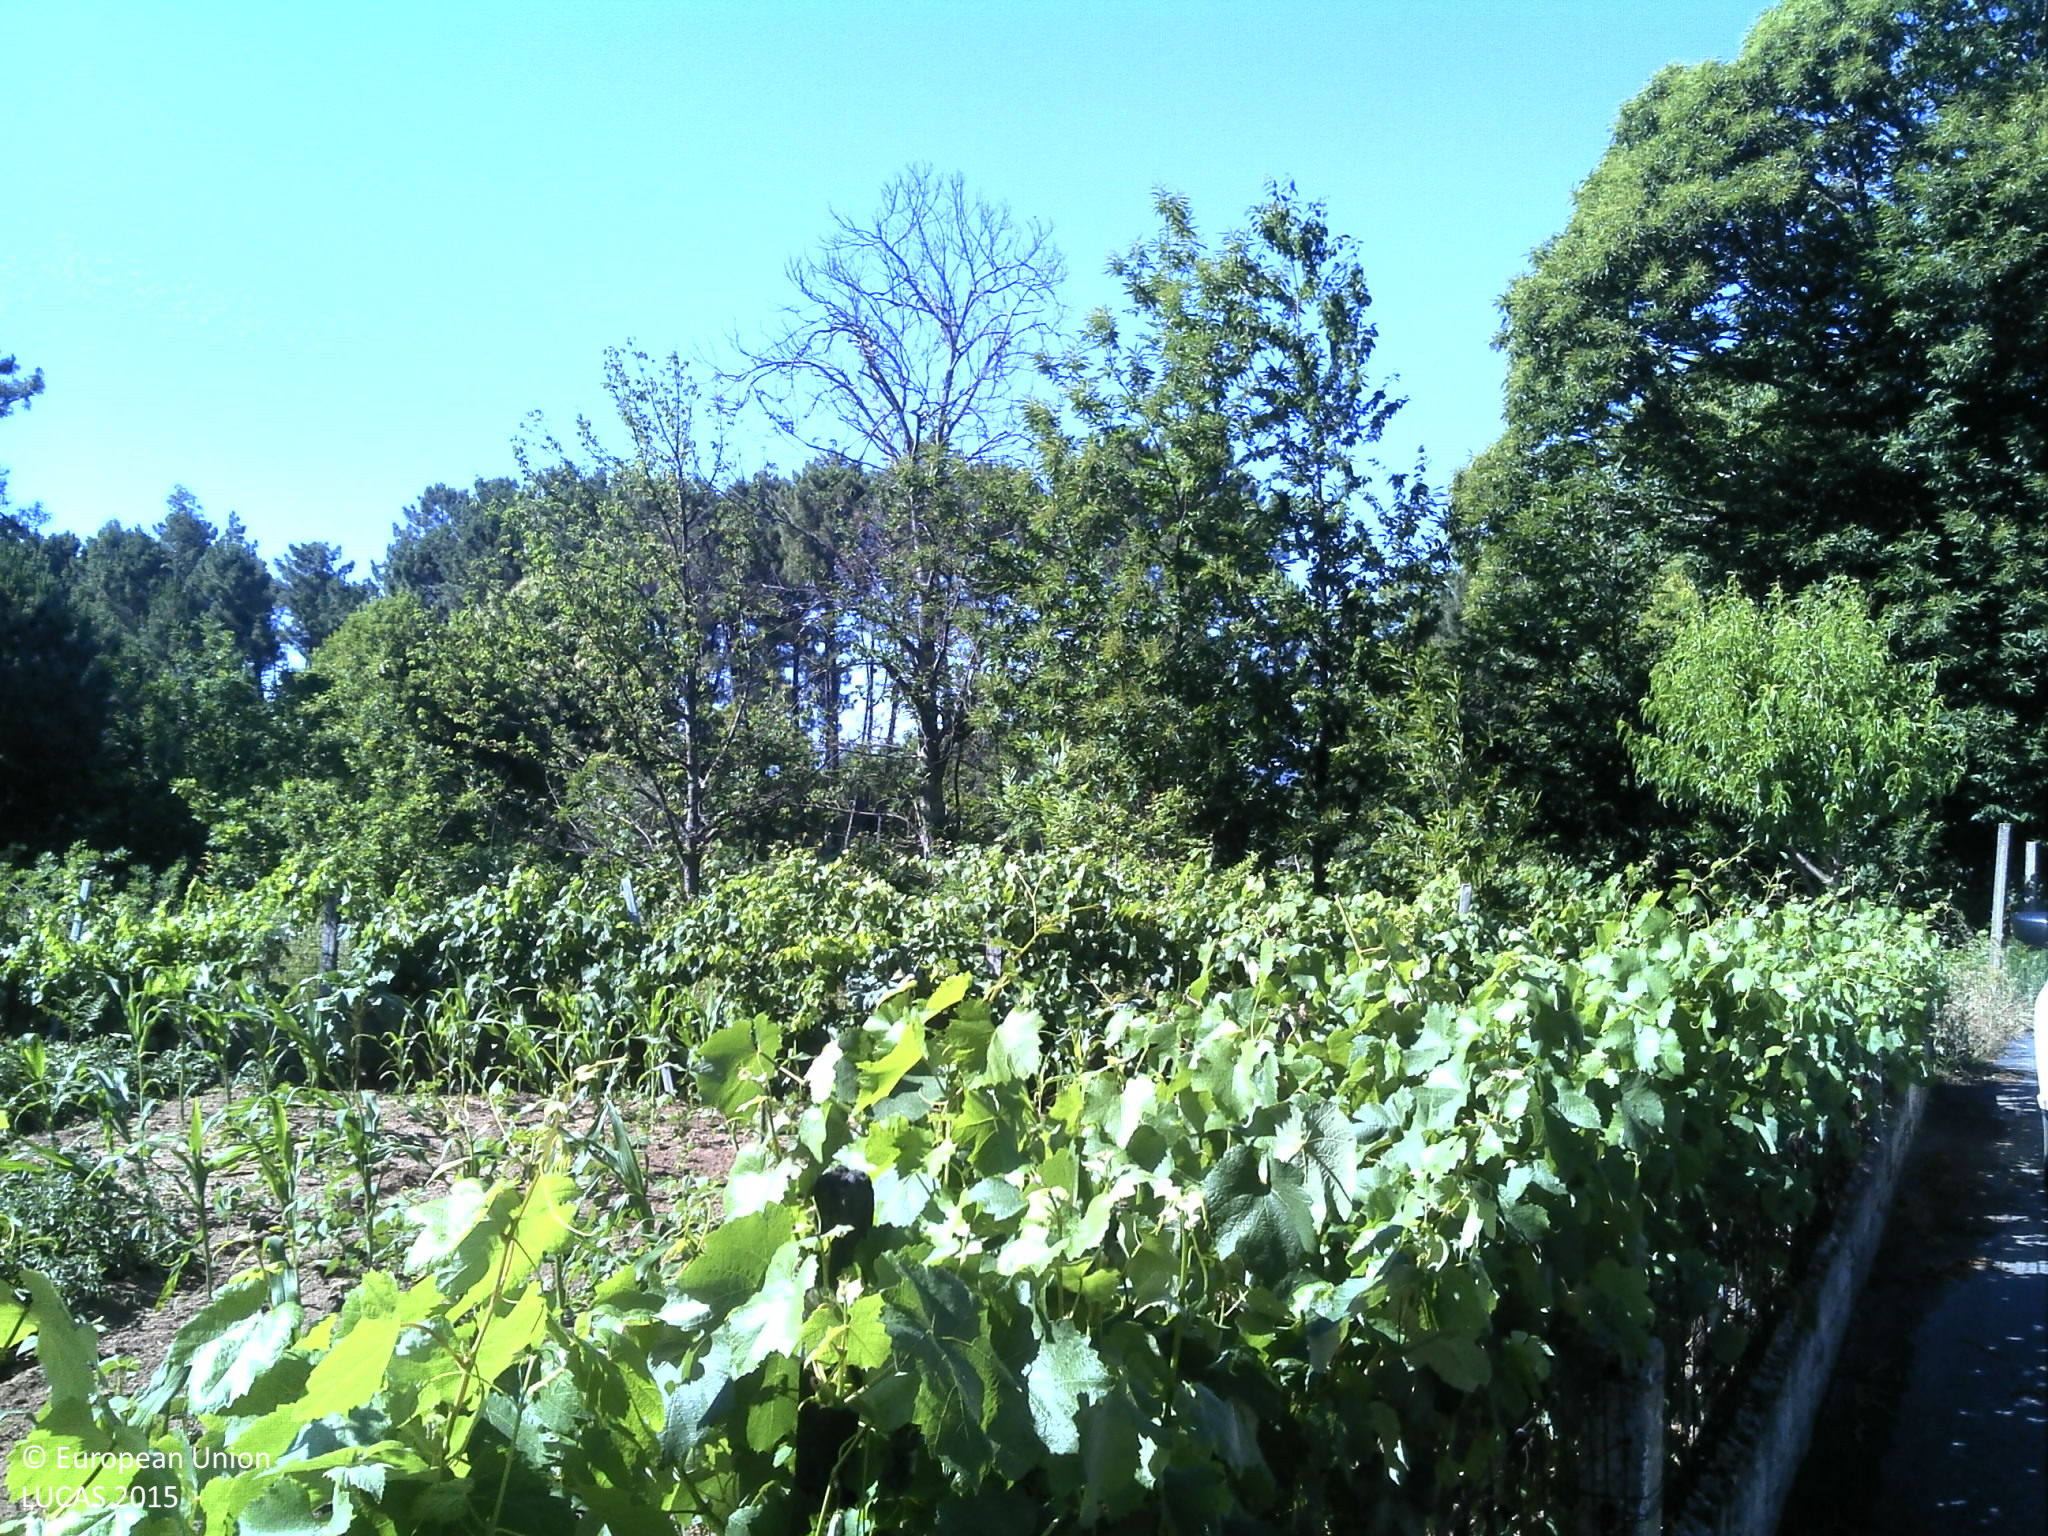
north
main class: Cropland
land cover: Potatoes
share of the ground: > 75 %
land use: Agriculture (excluding fallow land and kitchen gardens)
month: June
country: PT
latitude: 40.7306
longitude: -7.8977
